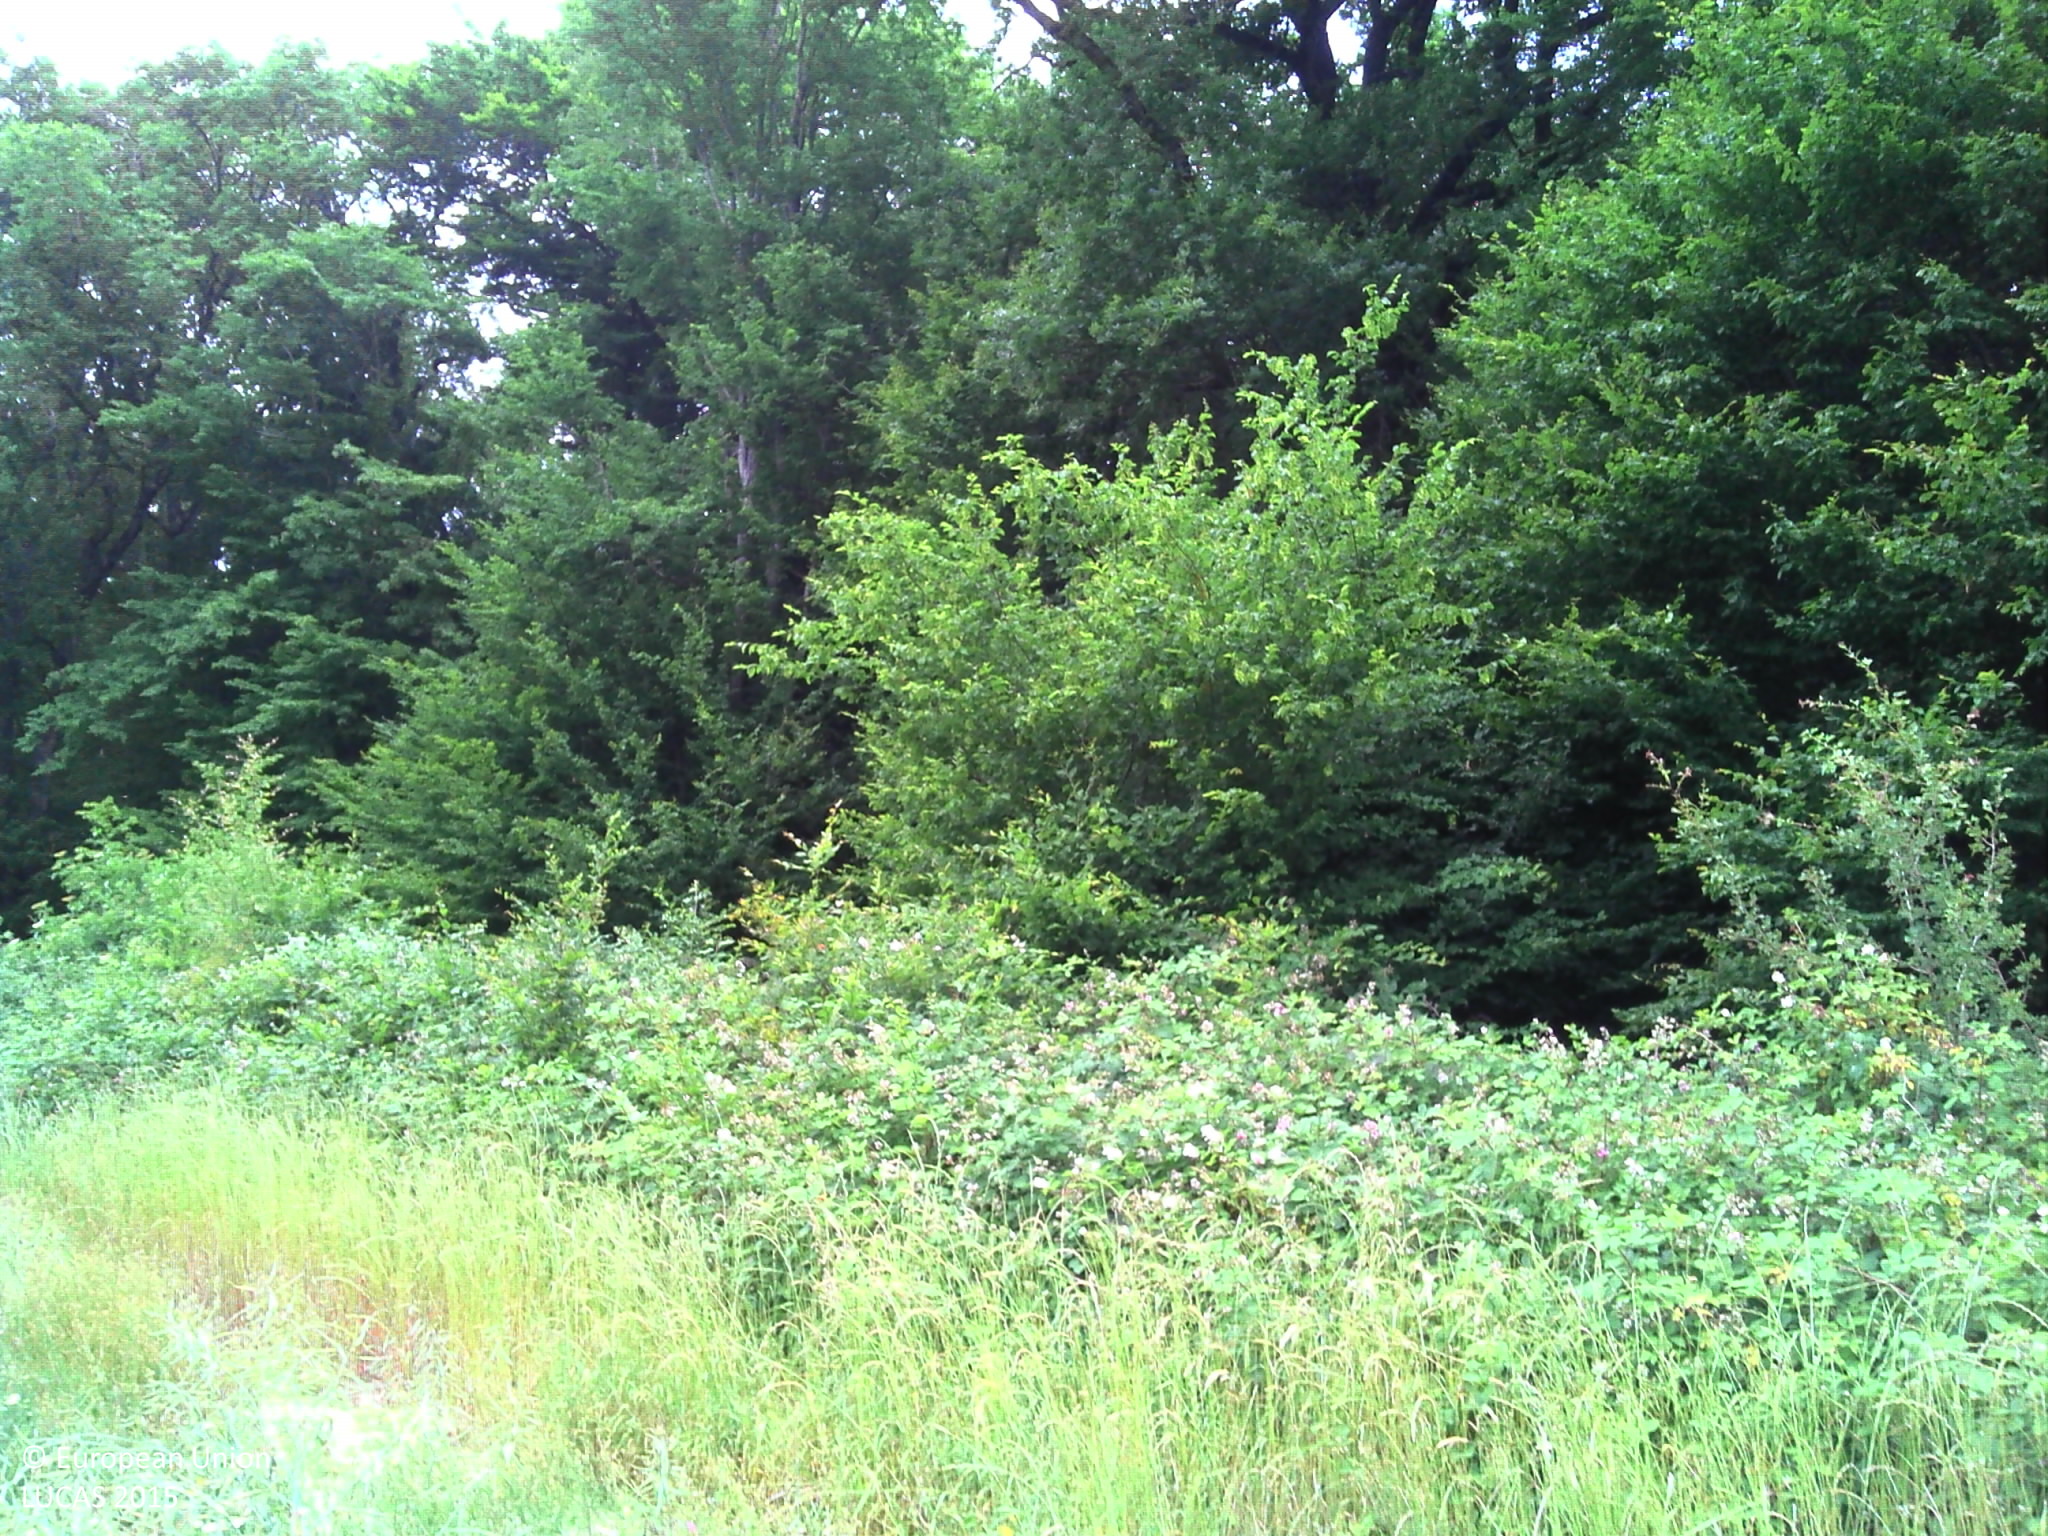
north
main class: Cropland
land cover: Rape and turnip rape
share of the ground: > 75 %
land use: Agriculture (excluding fallow land and kitchen gardens)
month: June
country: FR
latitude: 46.8047
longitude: 2.6700
